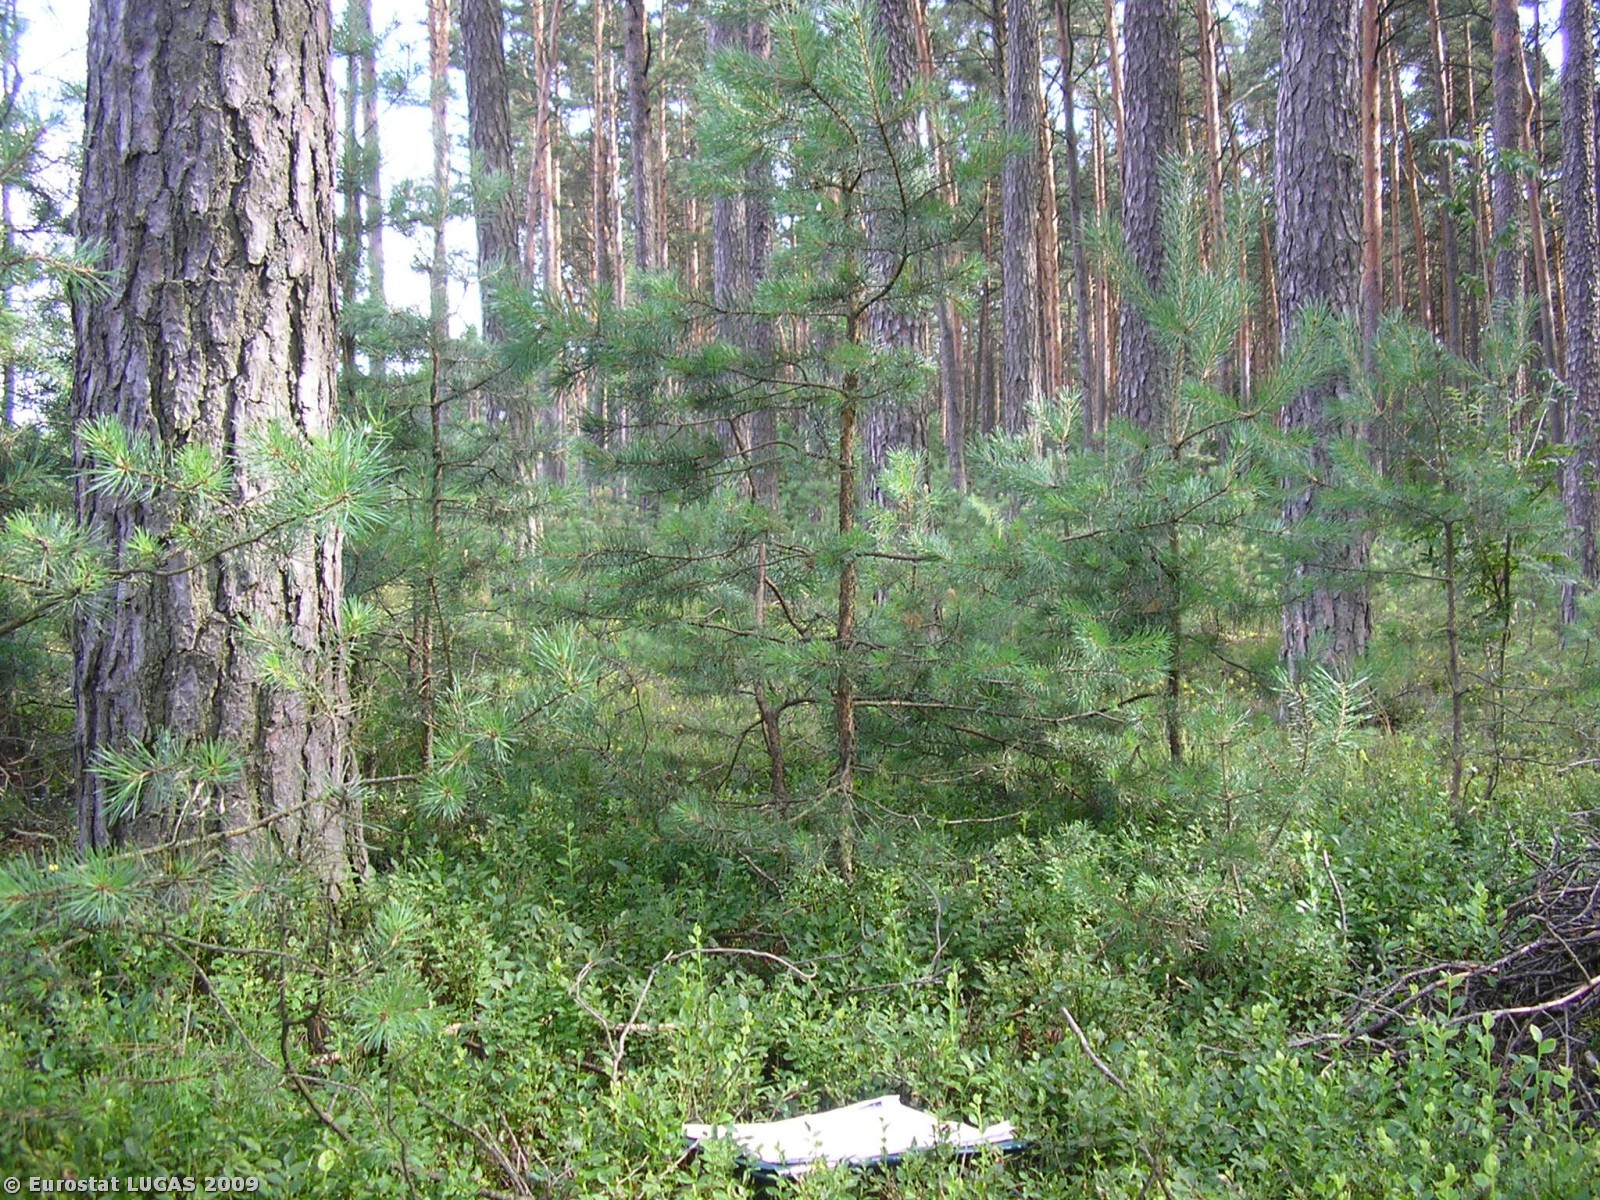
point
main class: Woodland
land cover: Coniferous woodland
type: hemiboreal forest and nemoral coniferous forest and mixed broadleaved-coniferous forest
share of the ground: > 75 %
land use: Forestry
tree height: > 5 m
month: July
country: PL
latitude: 51.4511
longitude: 21.5203
